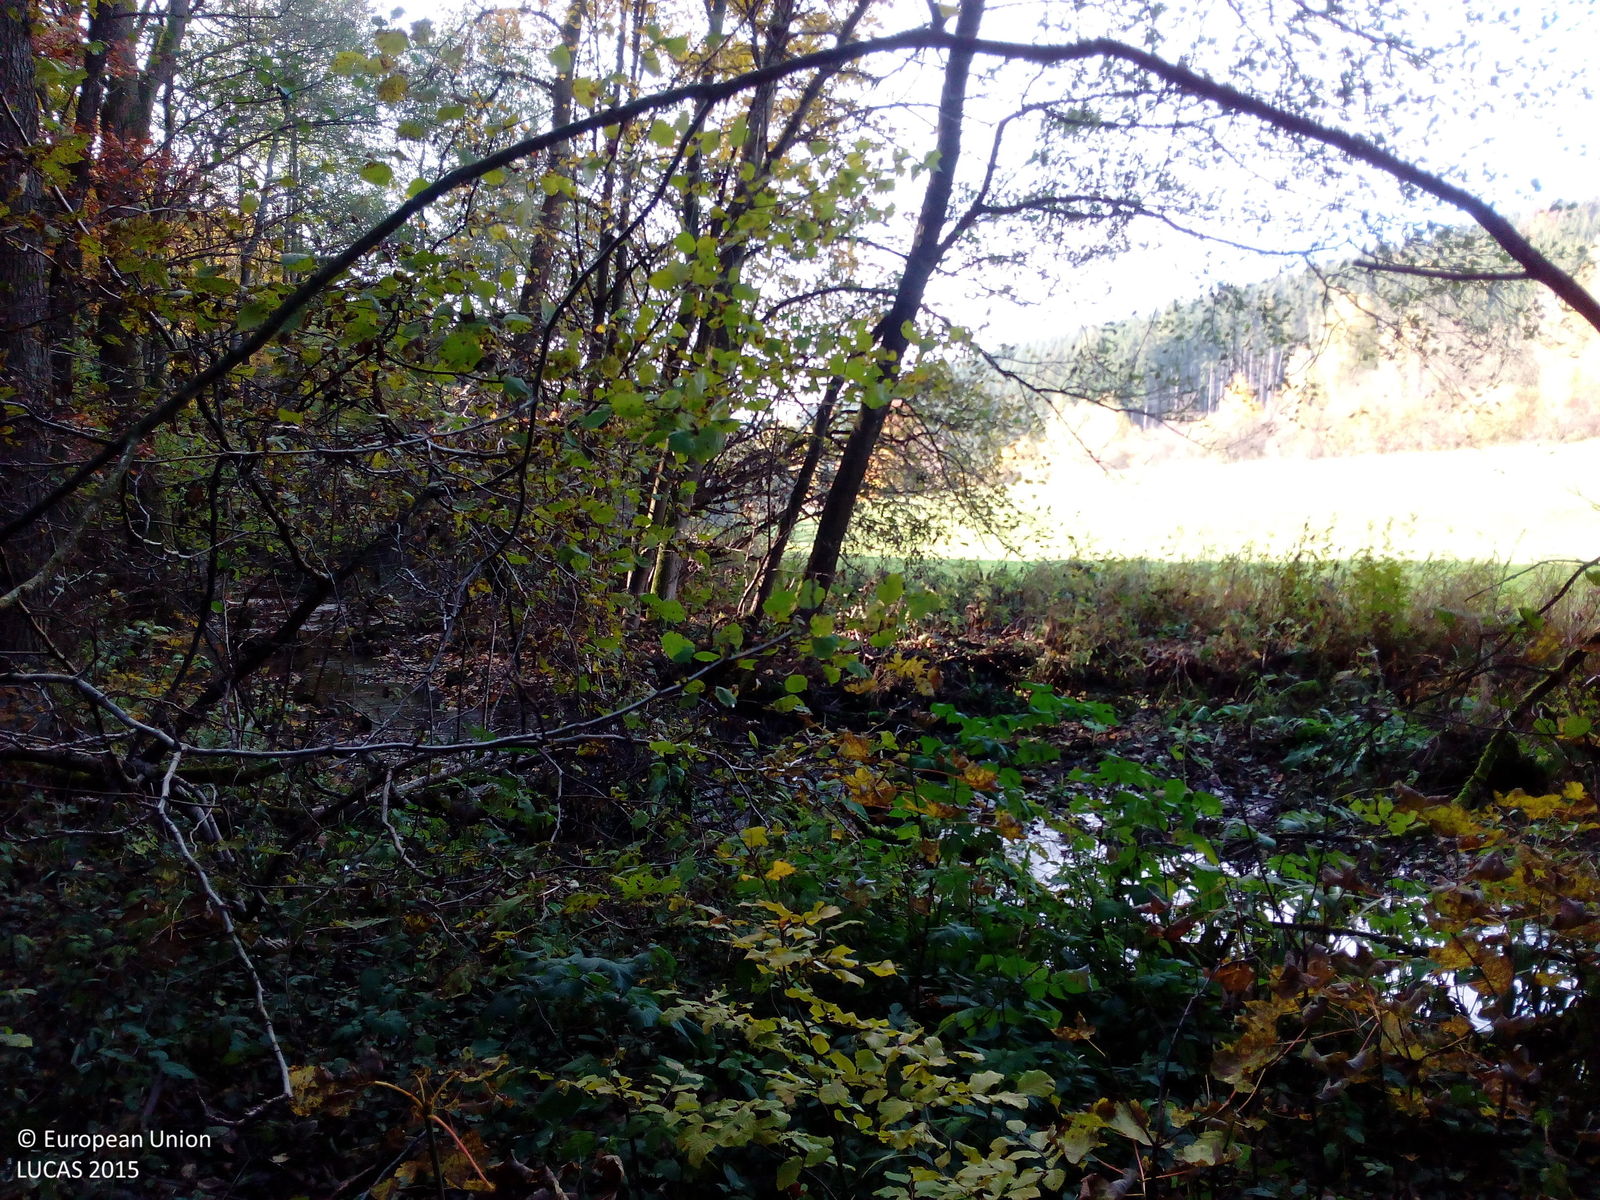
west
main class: Woodland
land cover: Broadleaved woodland
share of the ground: 50 - 75 %
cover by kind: broadleaved forest trees 45 %, coniferous forest trees 15 %, herbaceous plants 15 %, lichens and mosses 10 %, unconsolidated bare surface 10 %, shrubs 5 %
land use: Forestry
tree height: > 5 m
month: October
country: DE
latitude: 50.3820
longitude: 9.9297
